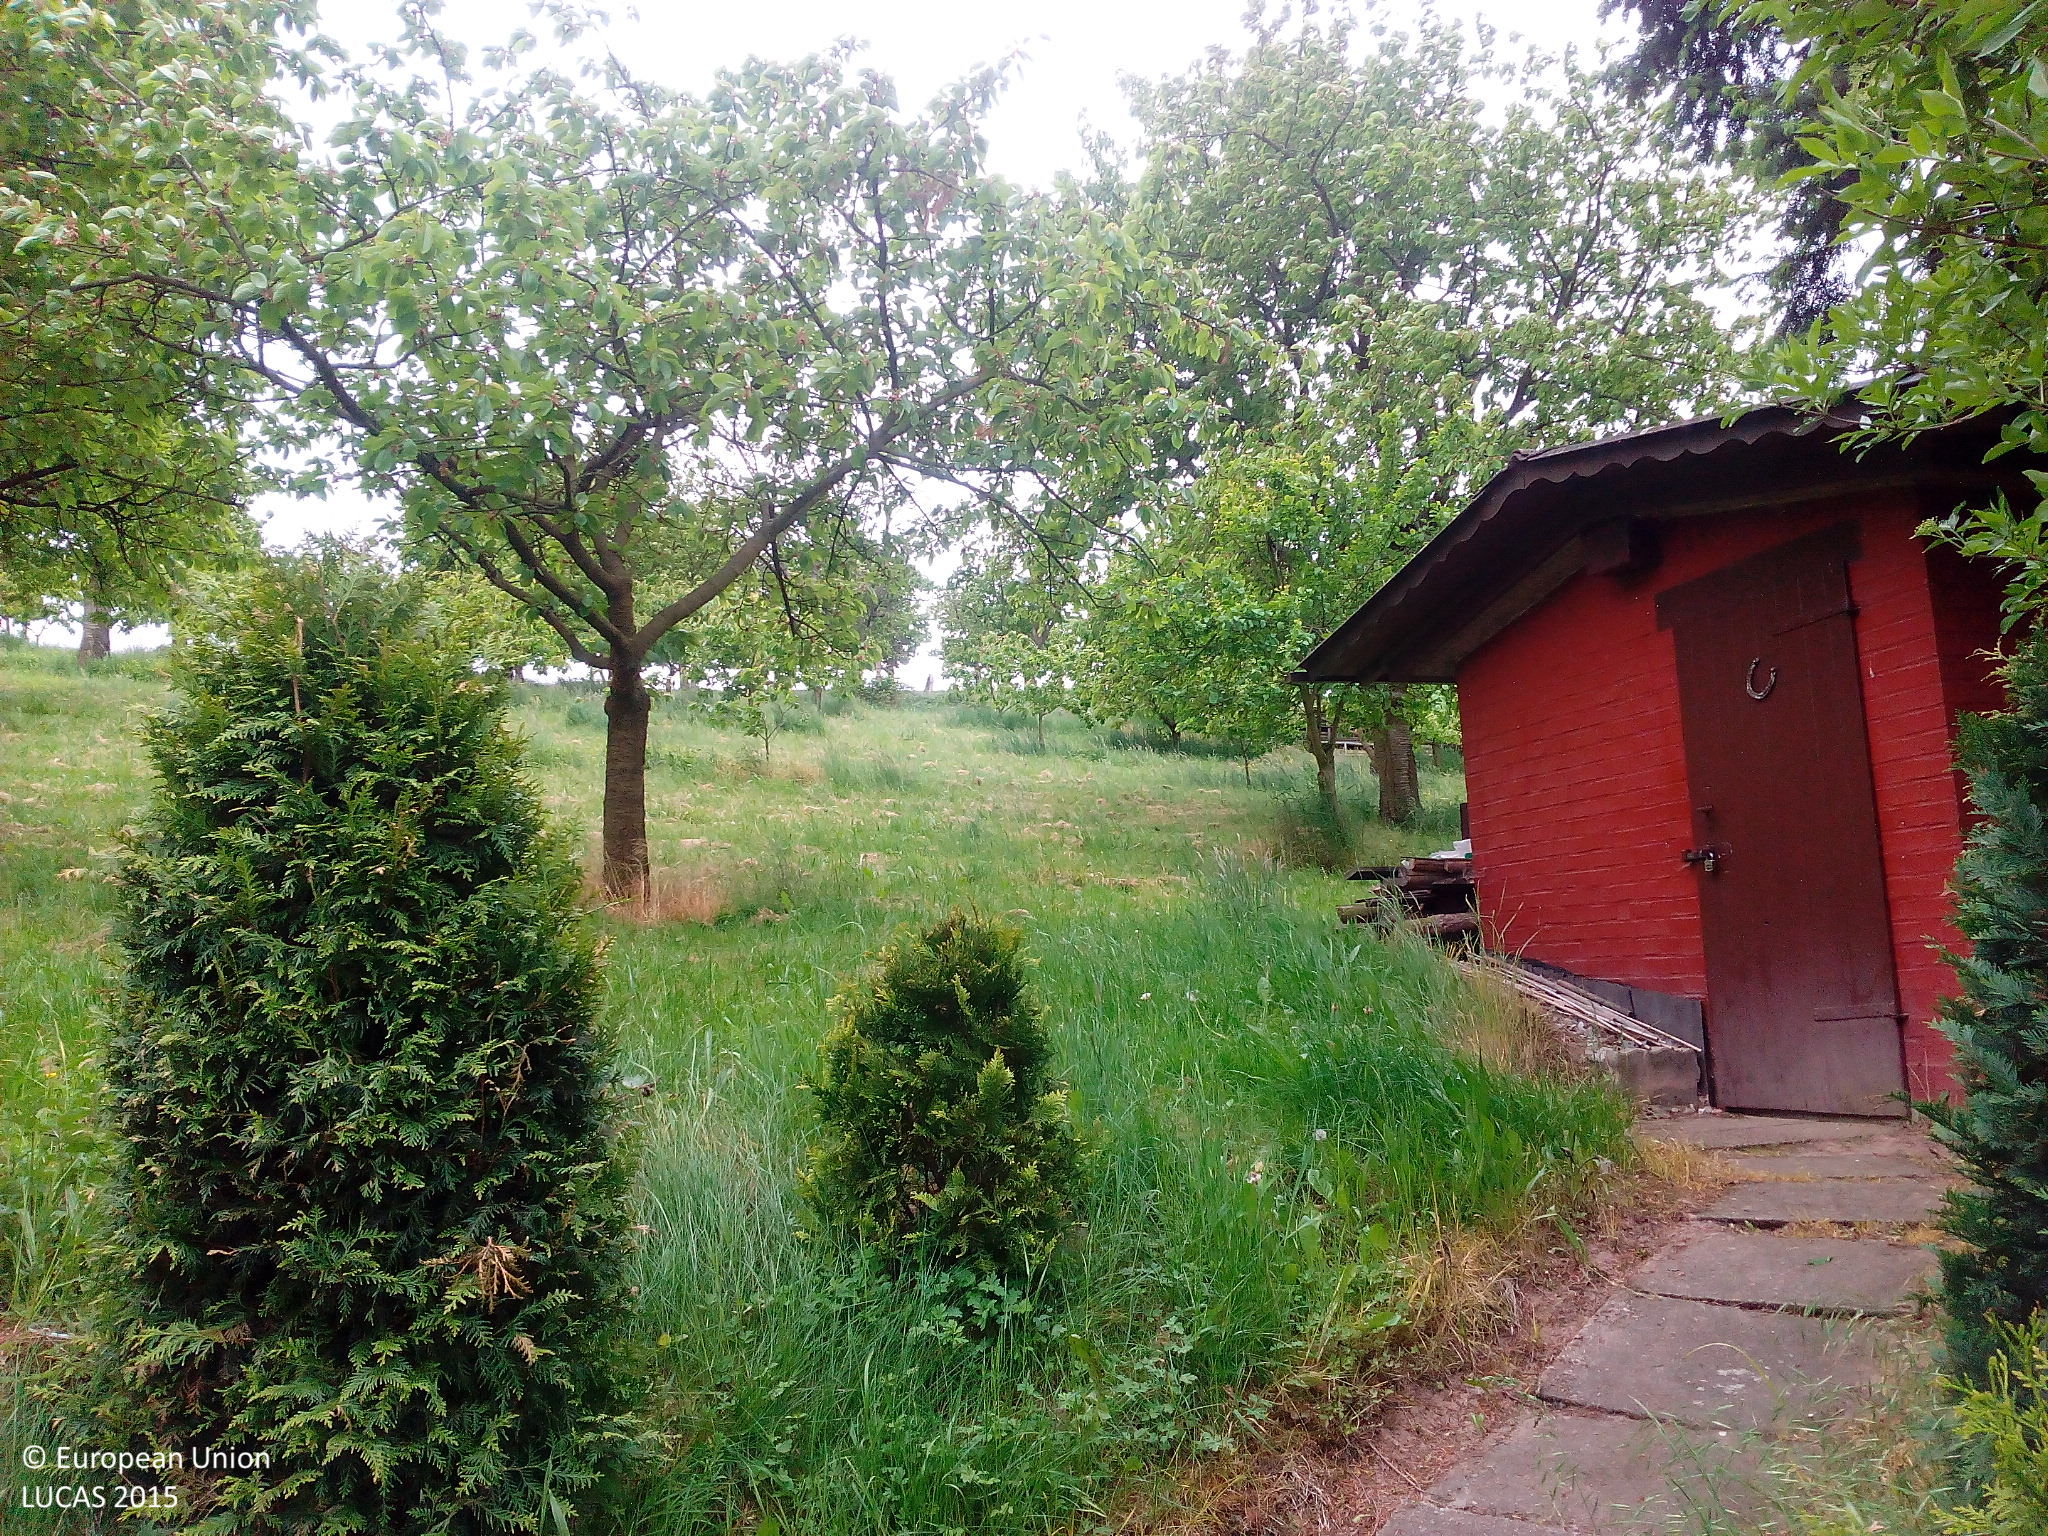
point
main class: Cropland
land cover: Cherry fruit
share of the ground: 10 - 25 %
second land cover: Grassland without tree/shrub cover
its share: > 75 %
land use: Agriculture (excluding fallow land and kitchen gardens)
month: May
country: DE
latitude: 51.2988
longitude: 9.8423
